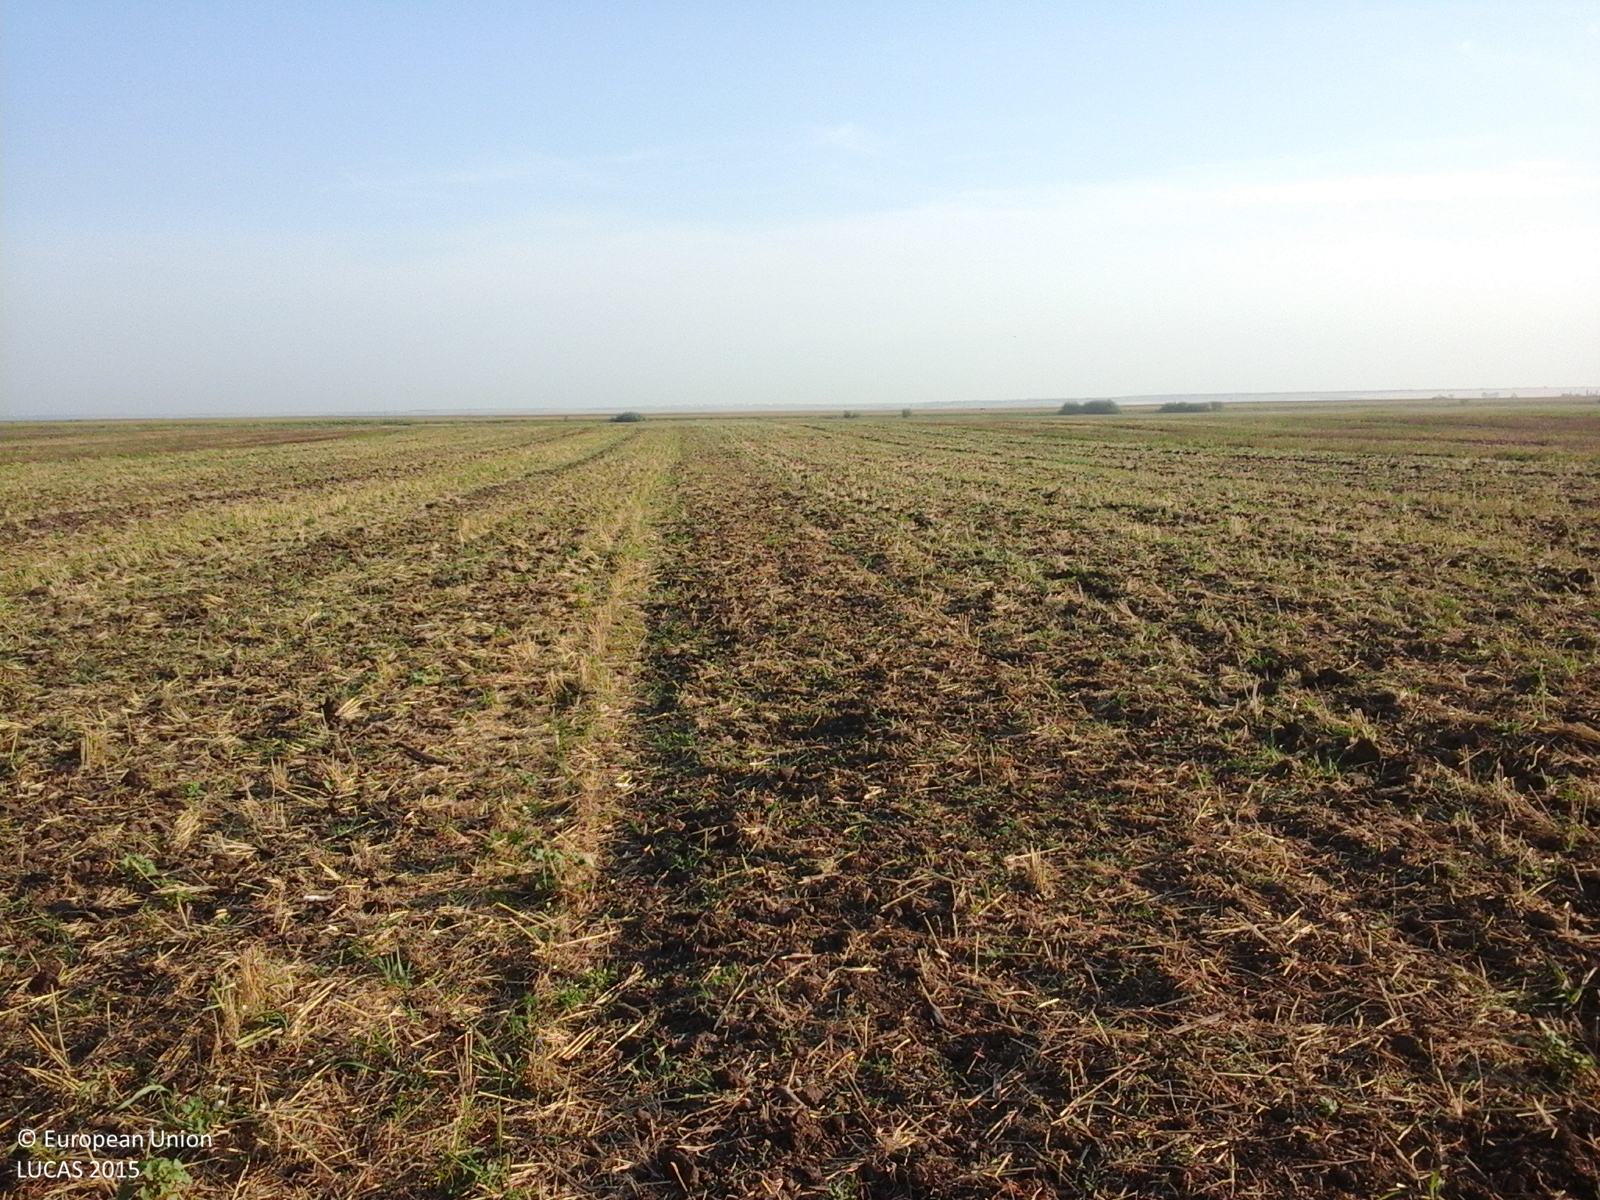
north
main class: Cropland
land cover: Common wheat
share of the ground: 50 - 75 %
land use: Agriculture (excluding fallow land and kitchen gardens)
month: August
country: RO
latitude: 44.0783
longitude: 23.2702
